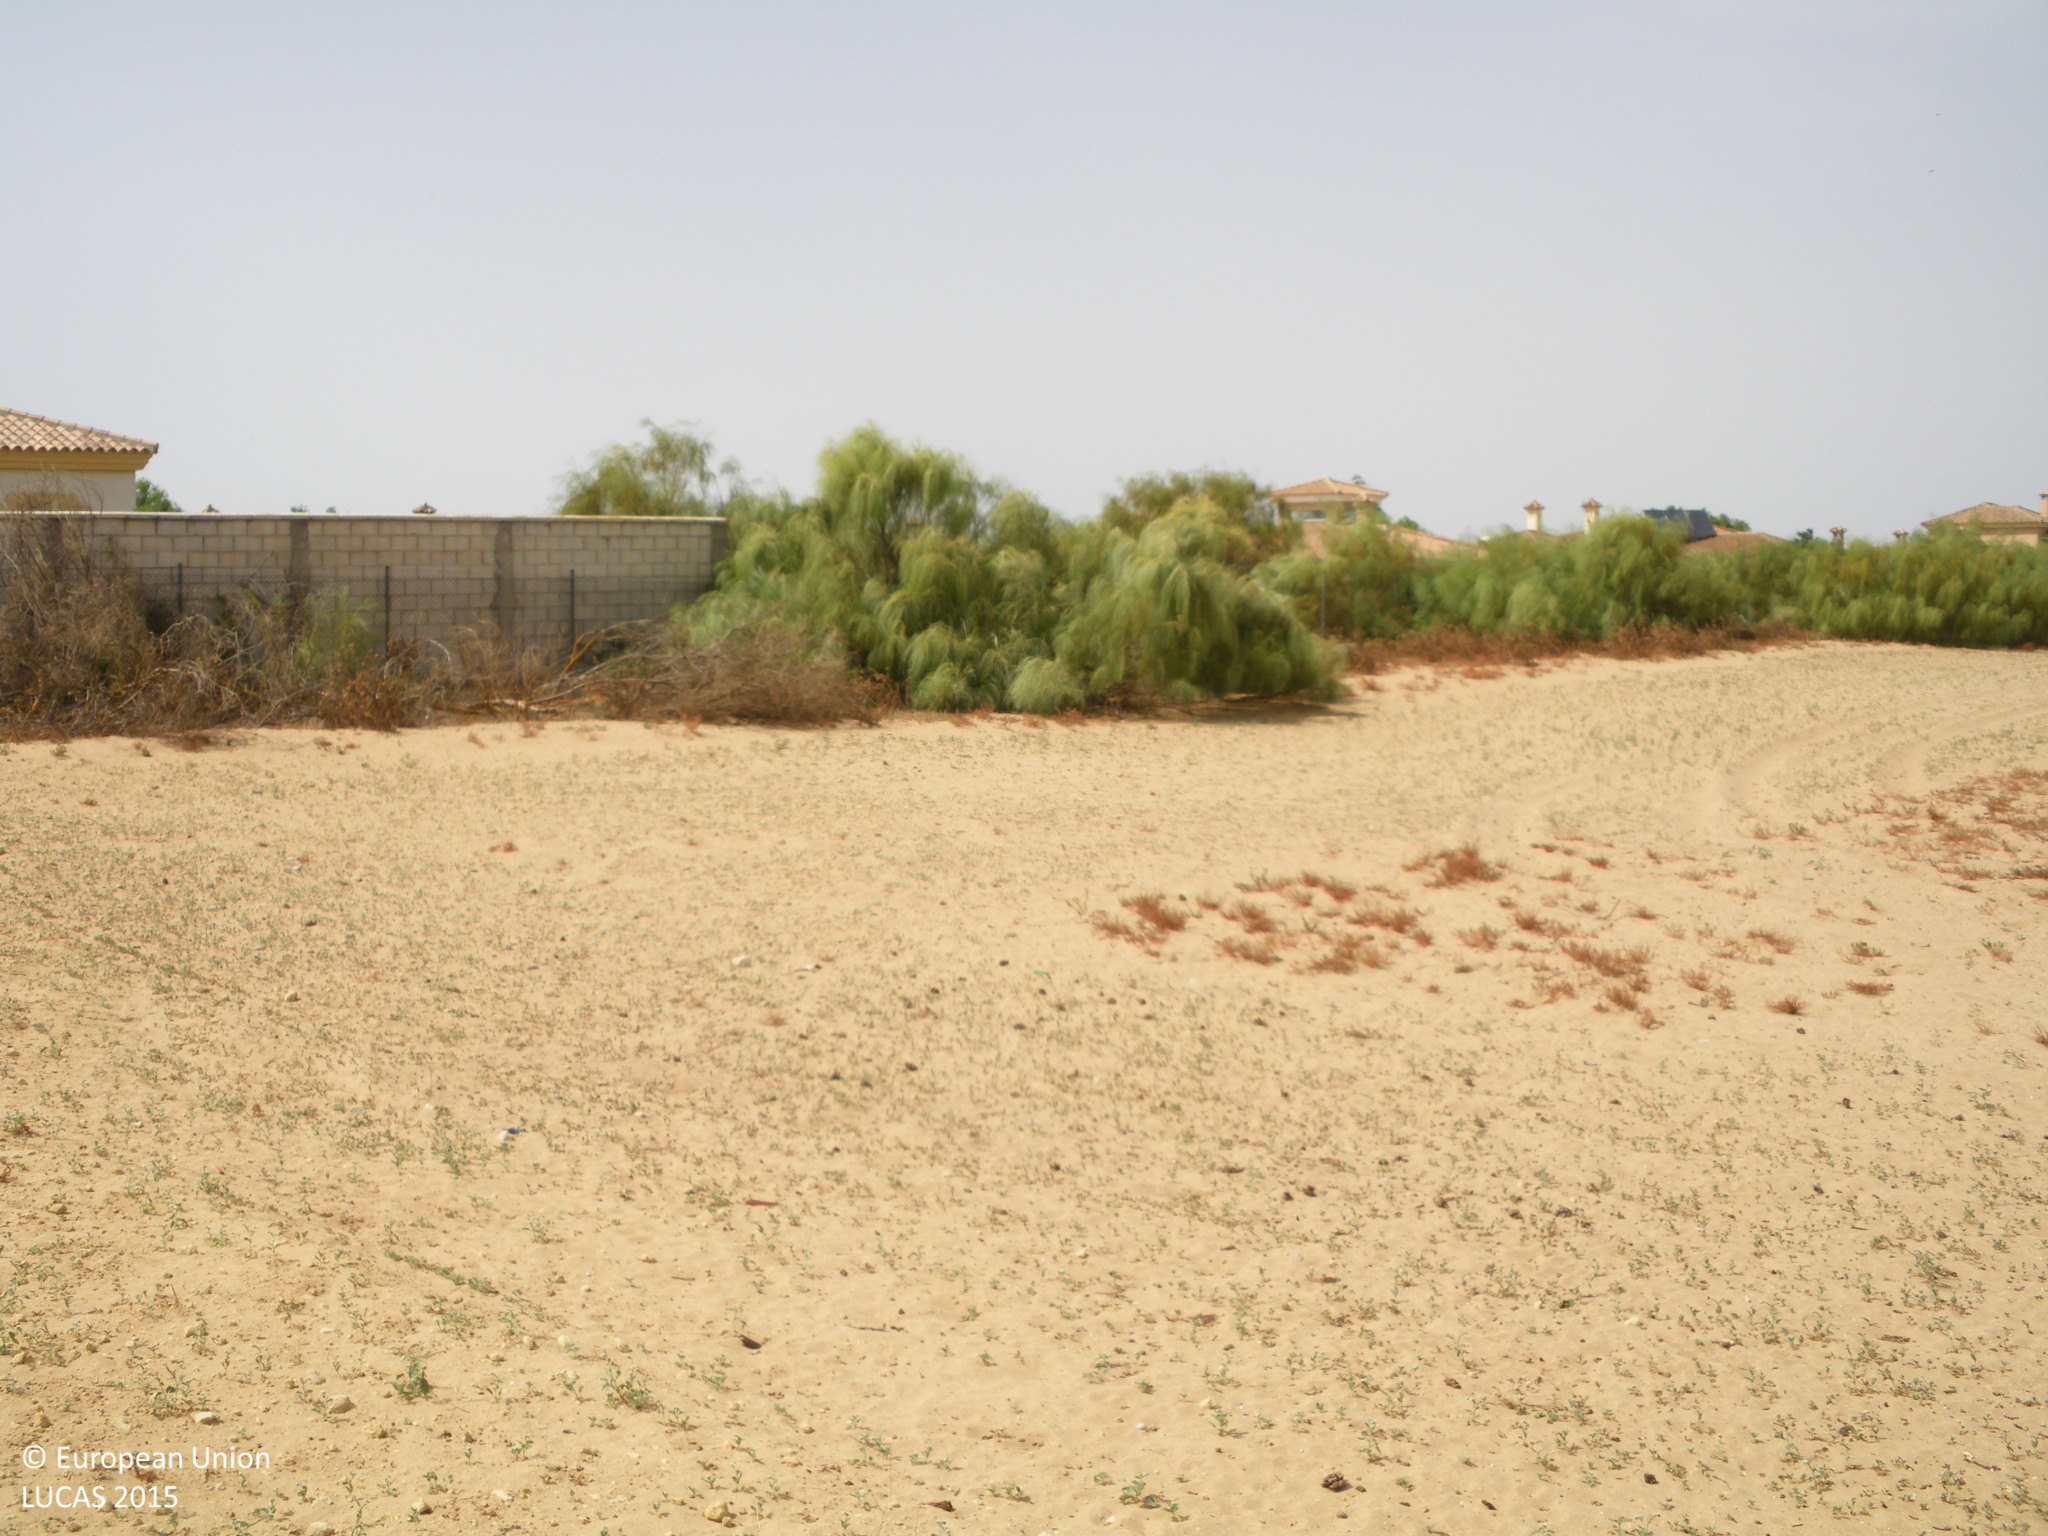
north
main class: Grassland
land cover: Grassland without tree/shrub cover
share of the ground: 10 - 25 %
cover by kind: unconsolidated bare surface 85 %, herbaceous plants 15 %
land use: Semi-natural and natural areas not in use
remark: Clear cut
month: June
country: ES
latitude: 36.6150
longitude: -6.2586
